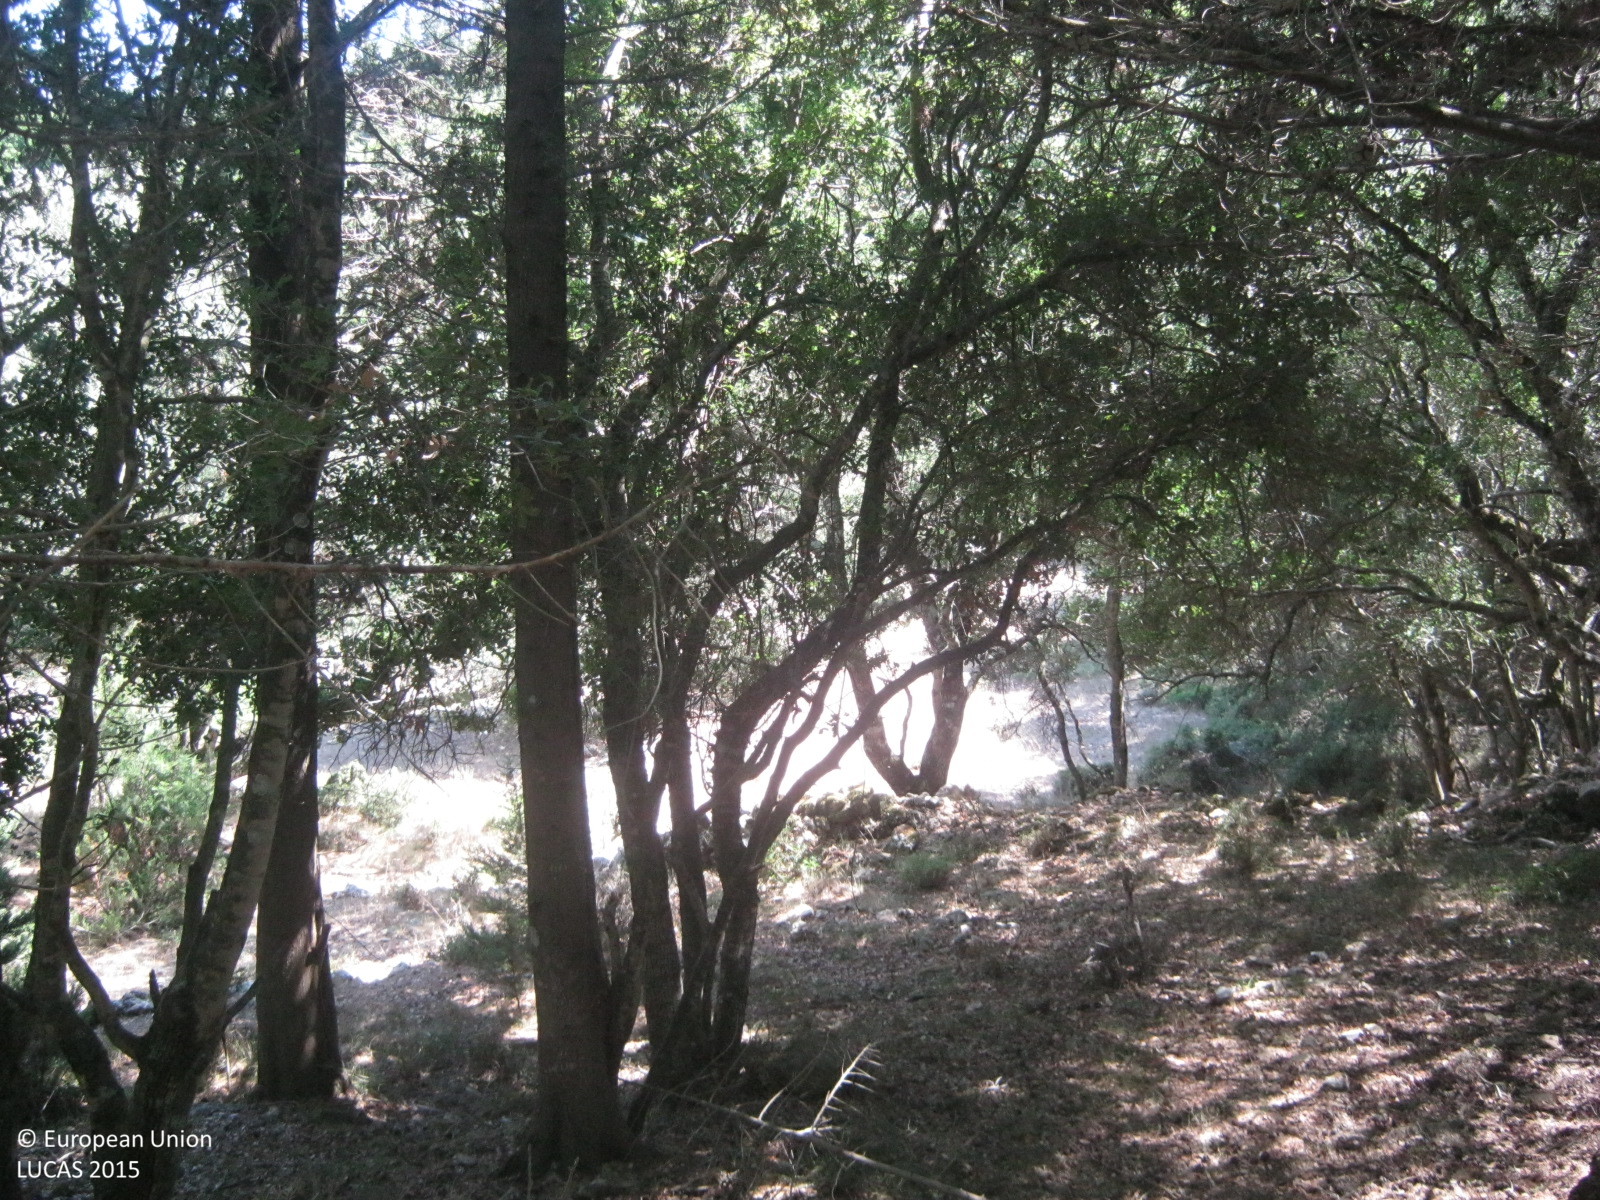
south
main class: Woodland
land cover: Broadleaved woodland
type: thermophilous deciduous forest
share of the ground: > 75 %
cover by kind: broadleaved forest trees 90 %, shrubs 5 %, consolidated bare surface 5 %
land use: Semi-natural and natural areas not in use
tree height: > 5 m
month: July
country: GR
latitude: 38.4187
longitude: 20.5581
